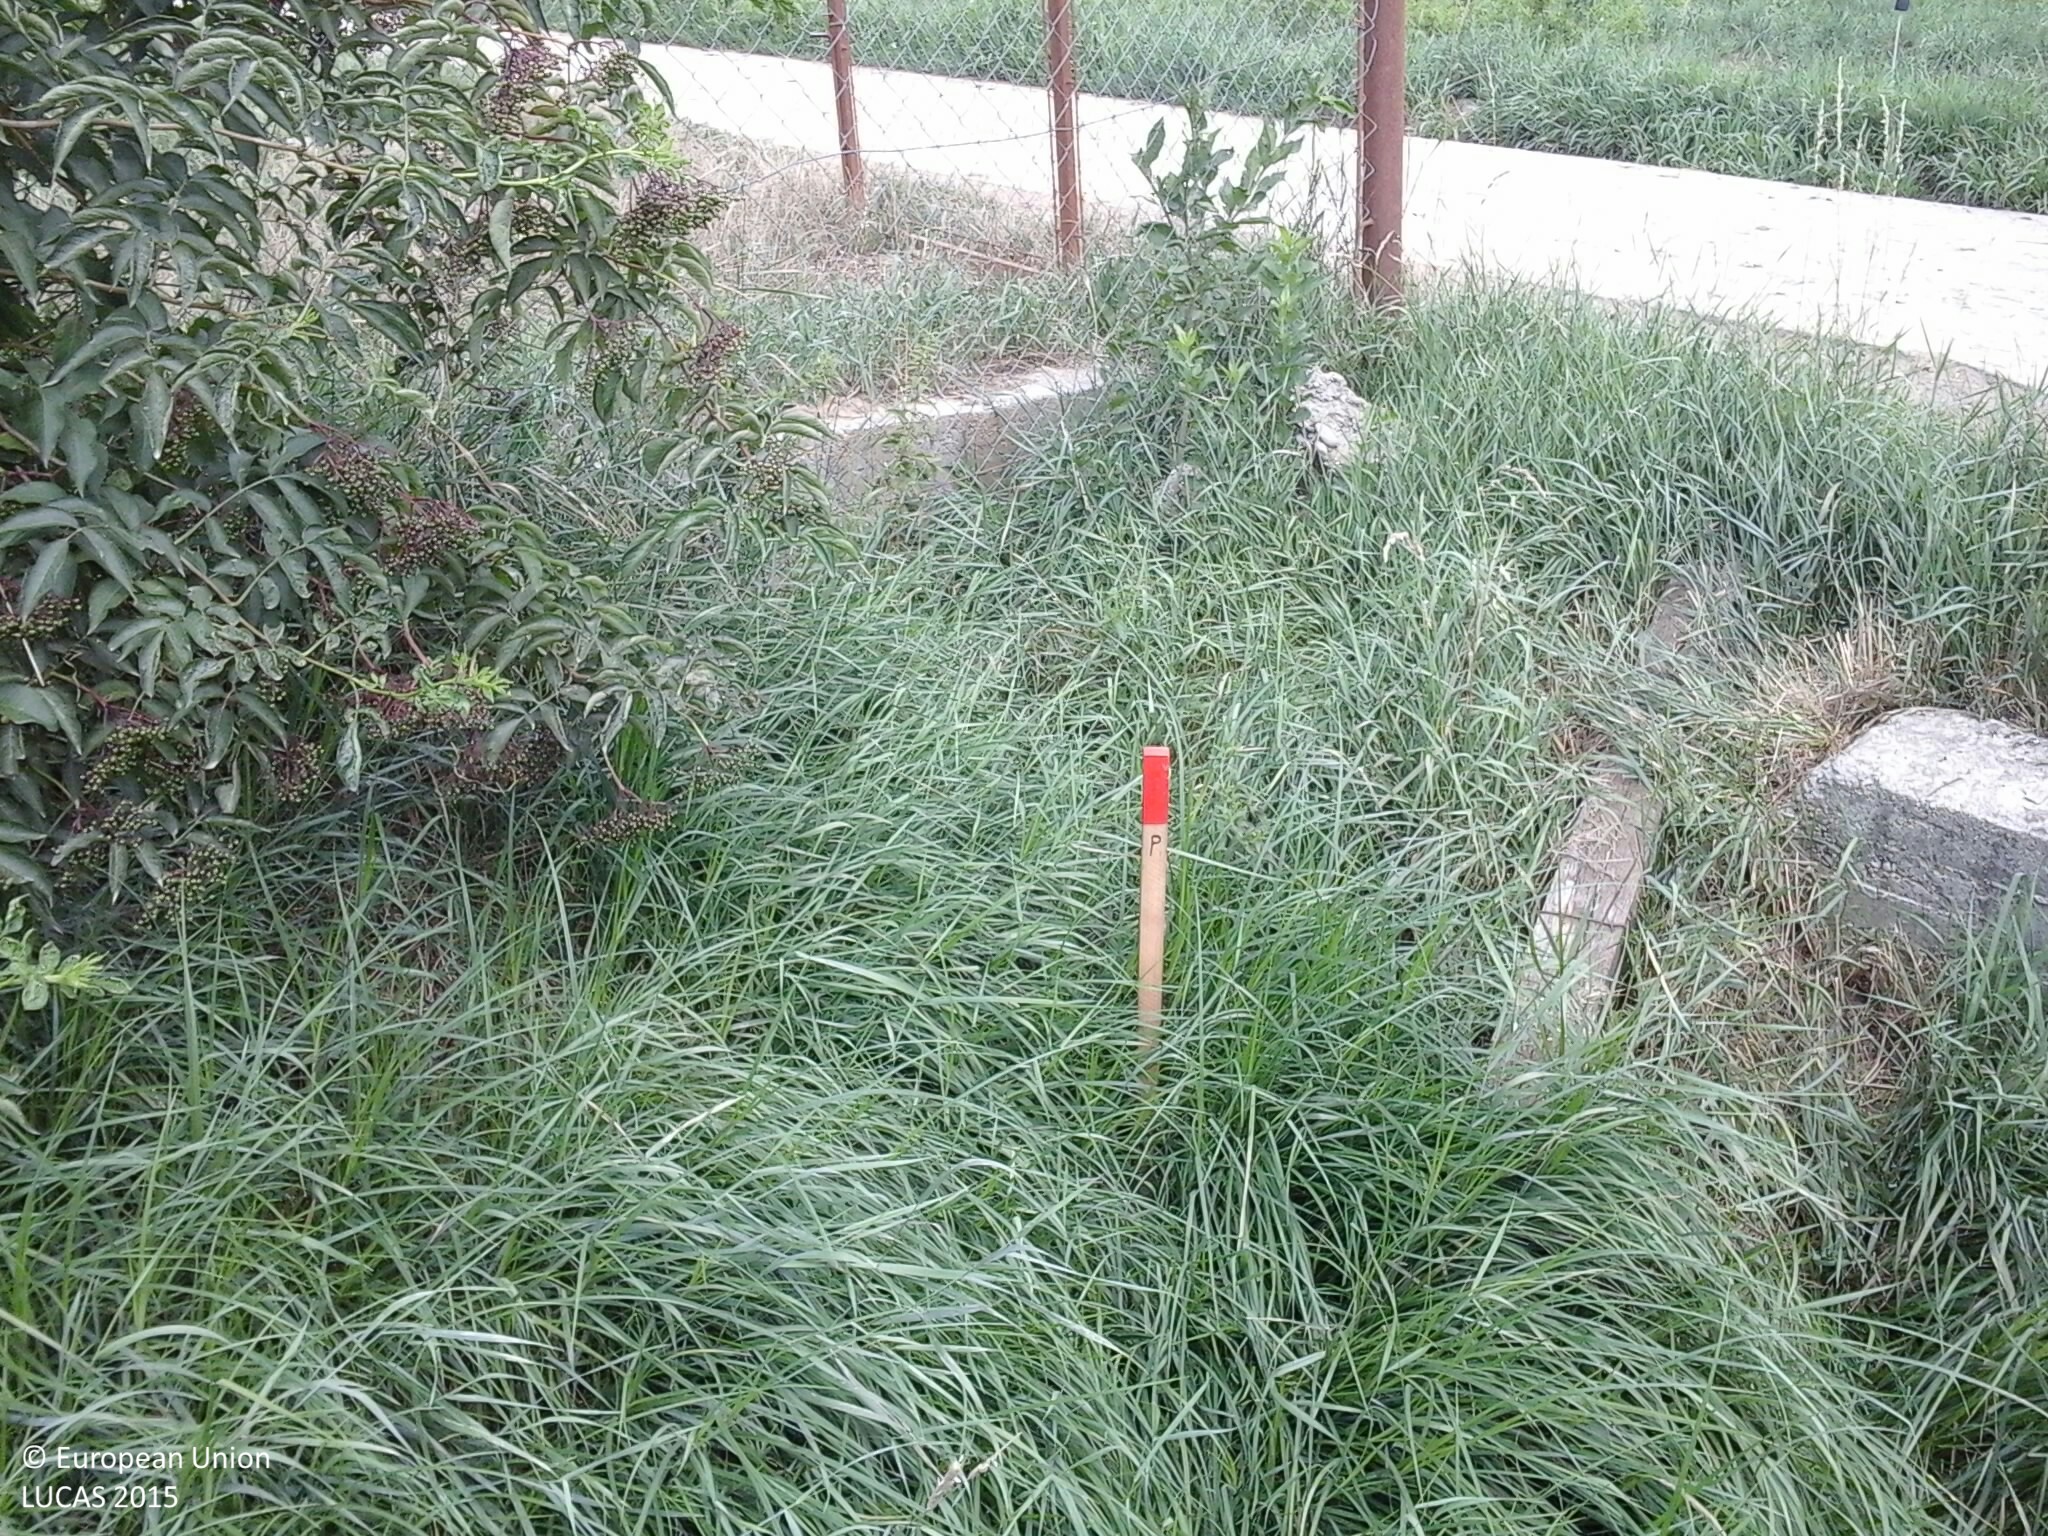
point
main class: Grassland
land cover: Grassland without tree/shrub cover
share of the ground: > 75 %
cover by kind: herbaceous plants 95 %, shrubs 5 %
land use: Road transport
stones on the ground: < 10 %
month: July
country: HU
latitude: 47.0196
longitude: 16.5148
